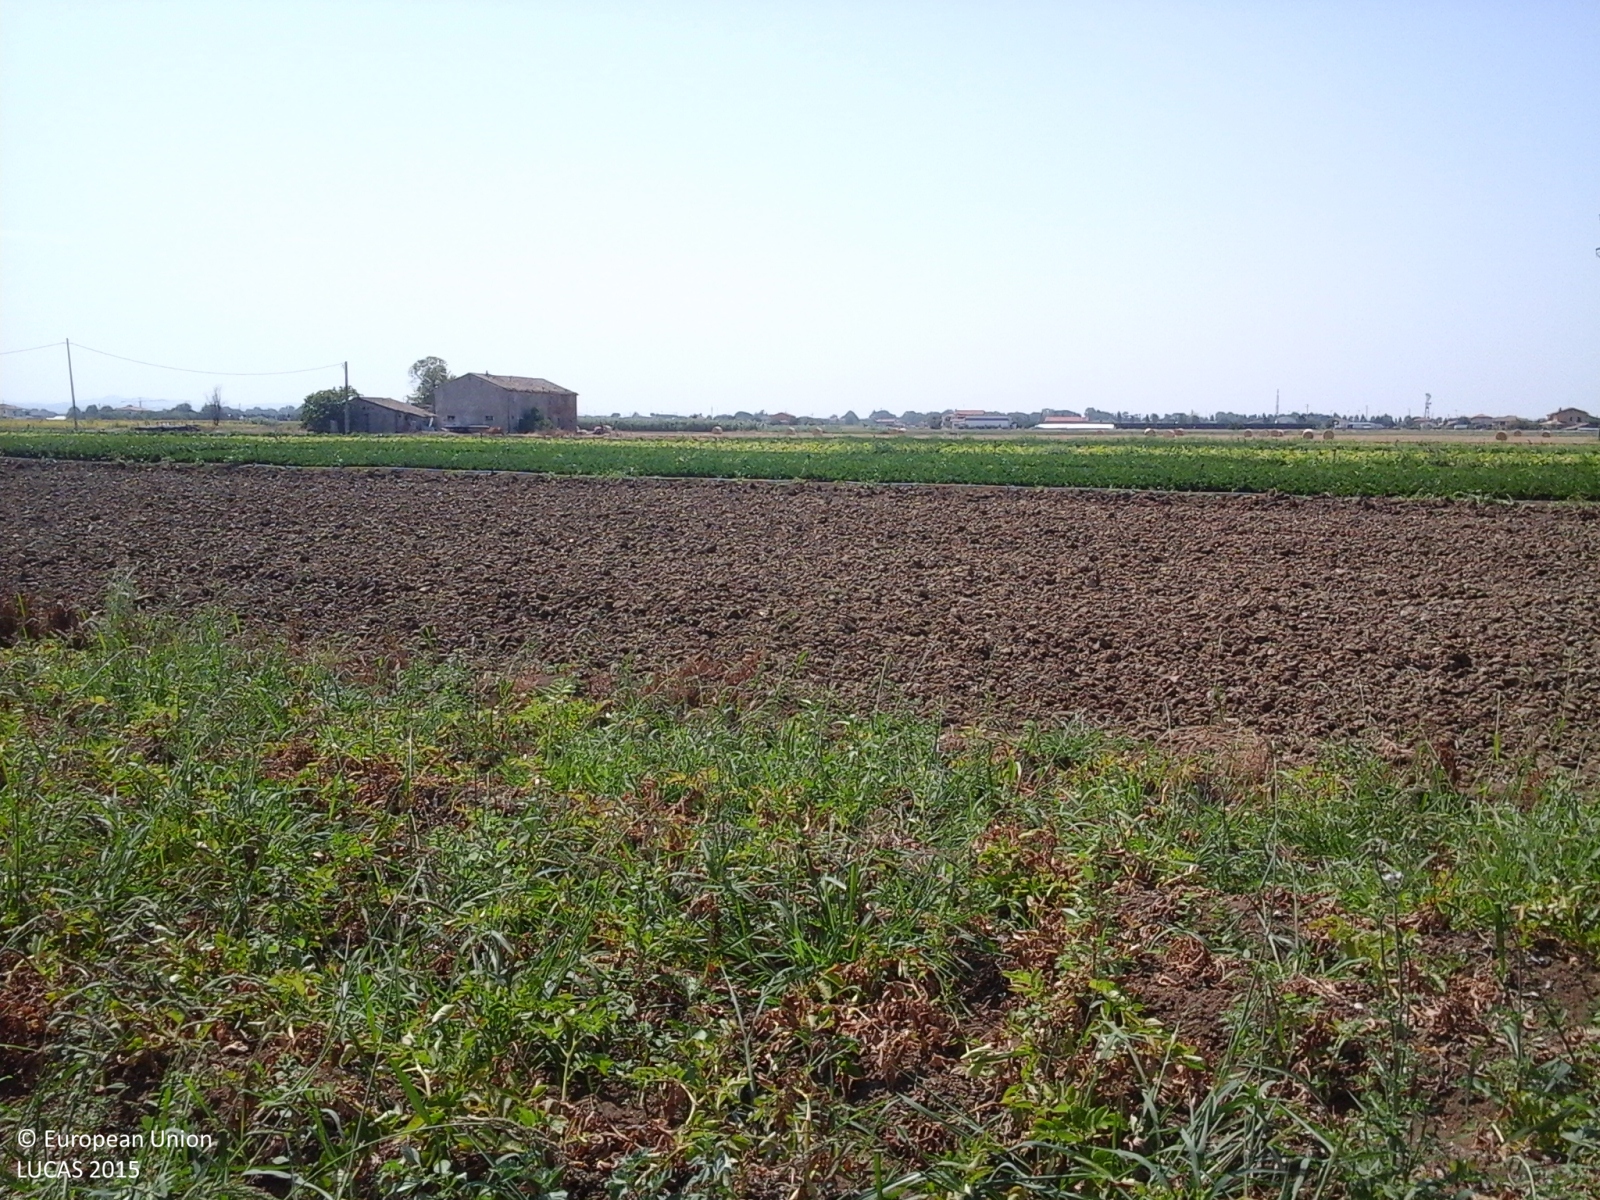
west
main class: Cropland
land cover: Potatoes
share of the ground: > 75 %
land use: Agriculture (excluding fallow land and kitchen gardens)
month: July
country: IT
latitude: 44.1416
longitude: 12.4322
